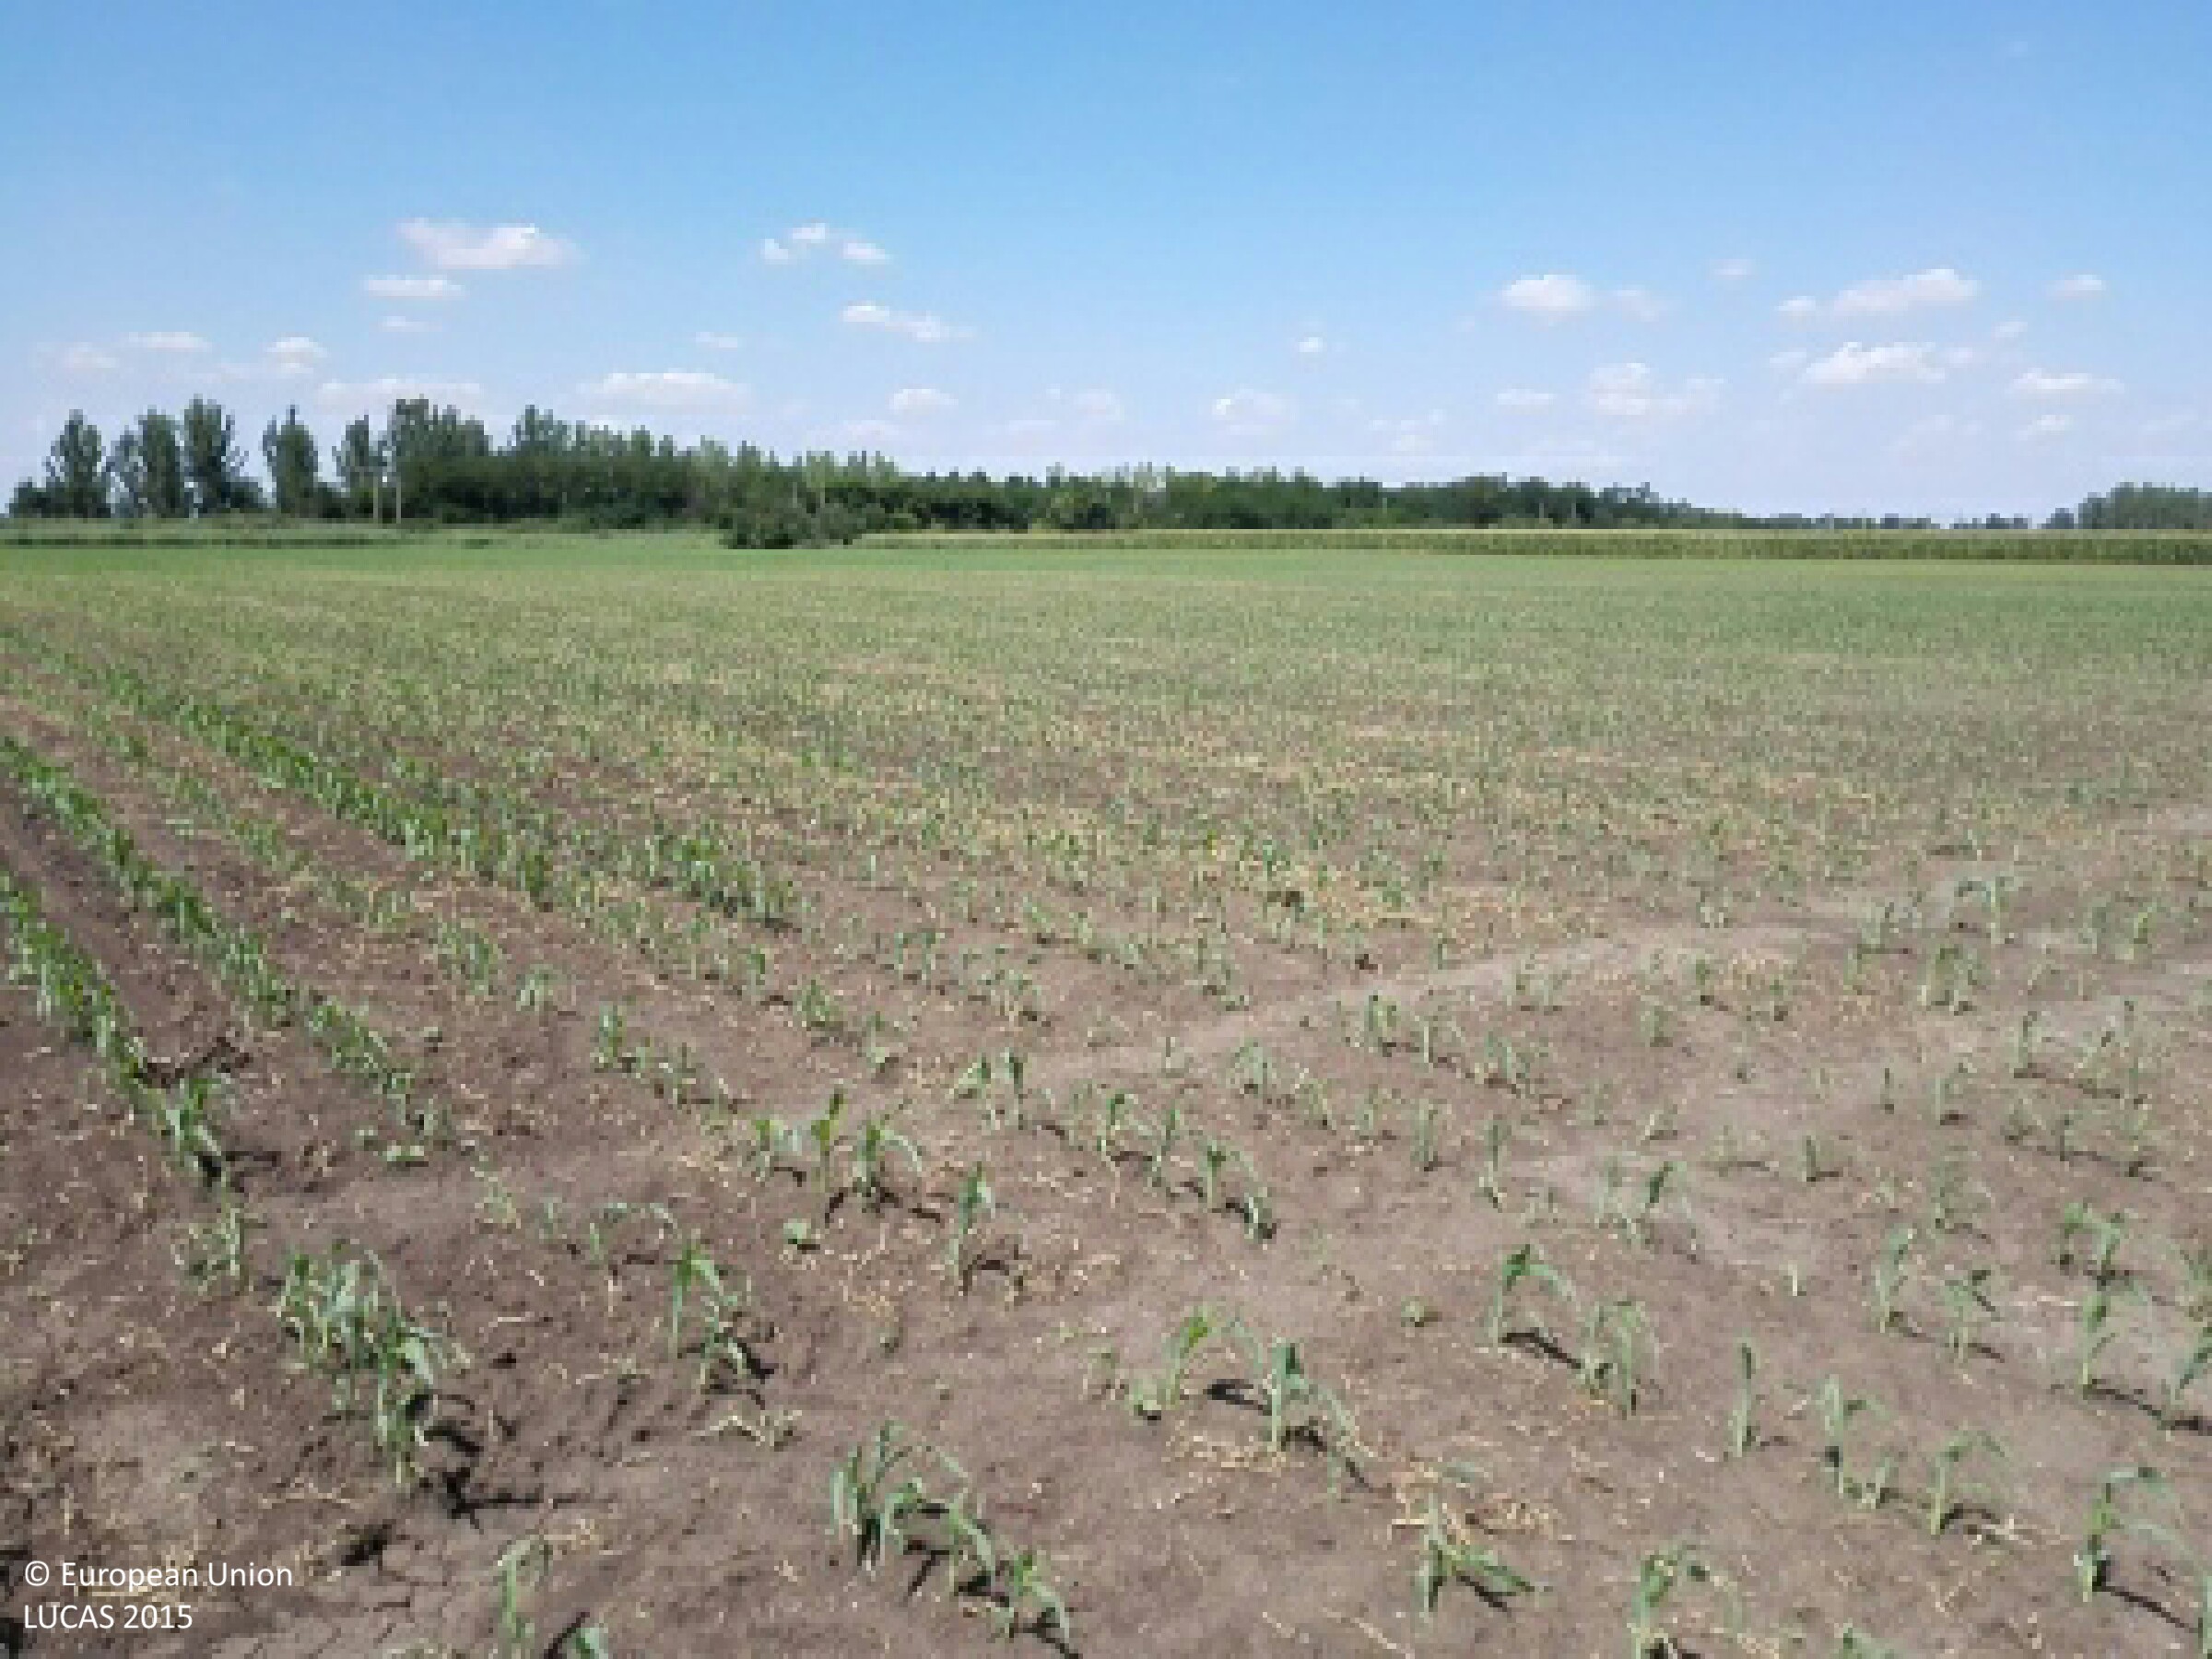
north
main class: Cropland
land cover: Maize
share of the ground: 10 - 25 %
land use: Agriculture (excluding fallow land and kitchen gardens)
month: July
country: HU
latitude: 47.3998
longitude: 21.3427
